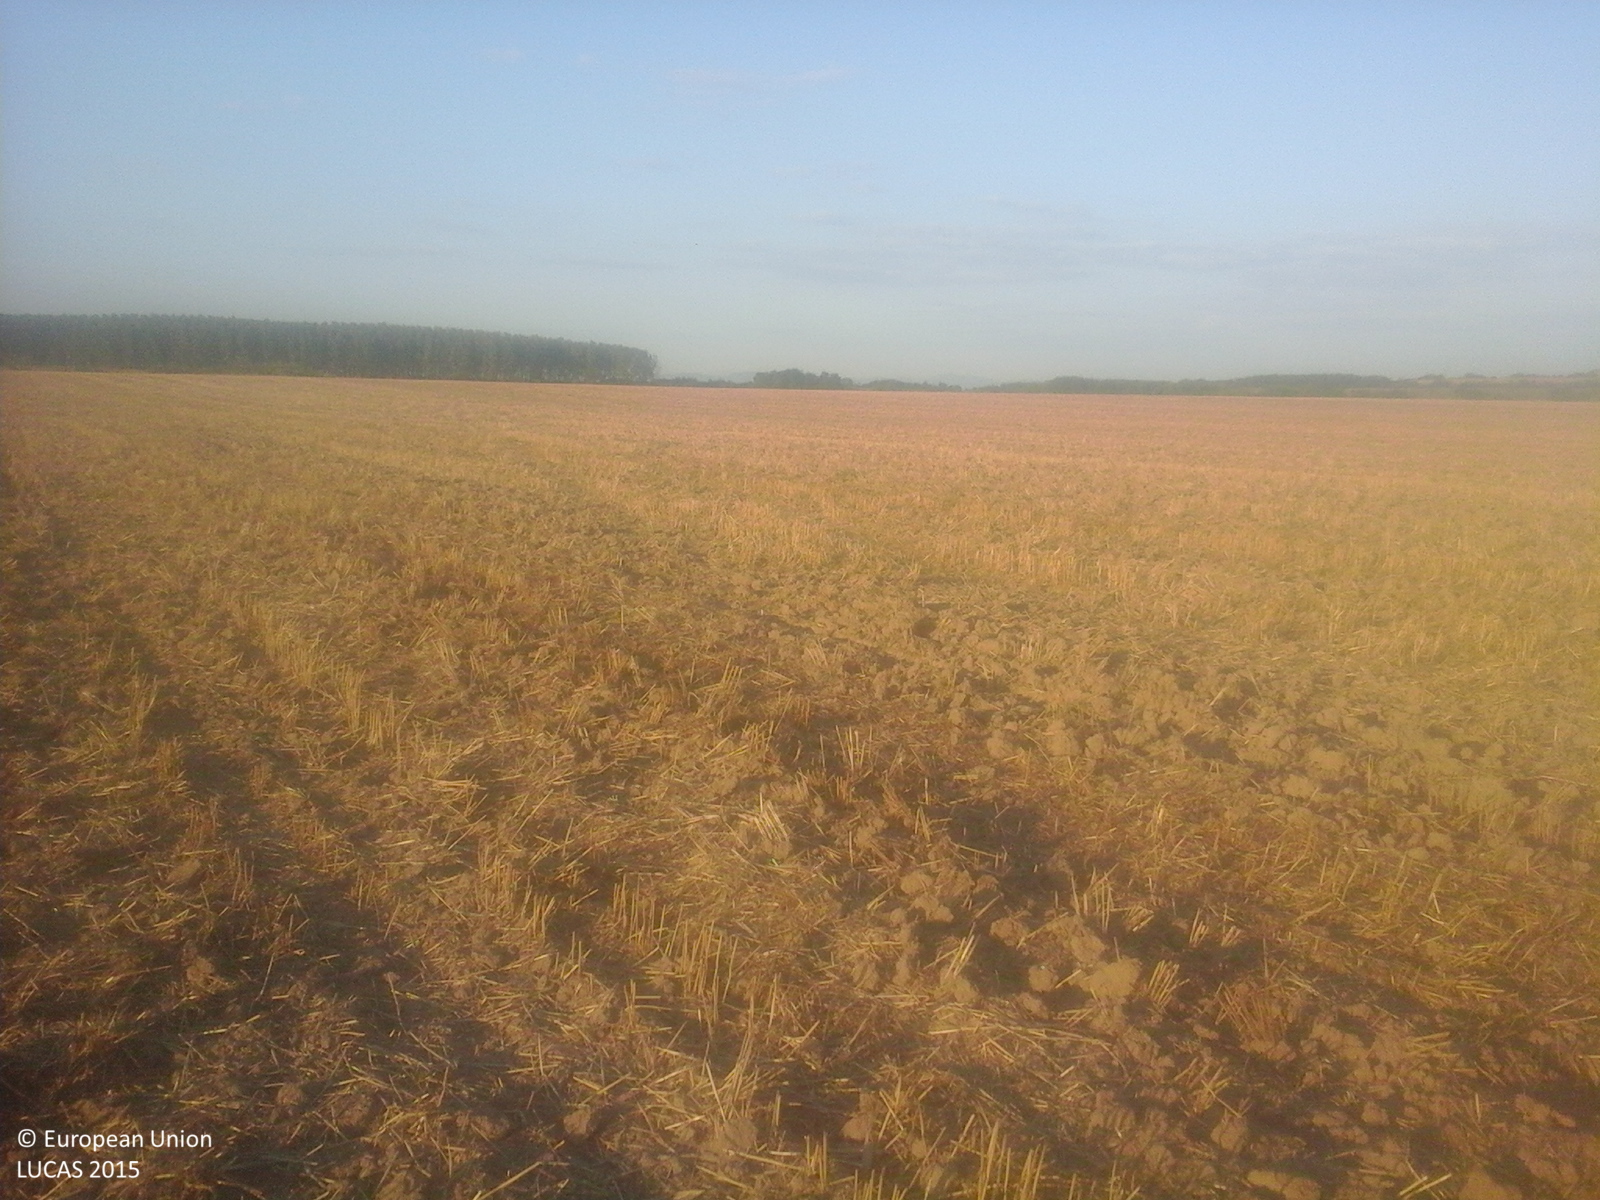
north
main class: Cropland
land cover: Common wheat
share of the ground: 10 - 25 %
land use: Agriculture (excluding fallow land and kitchen gardens)
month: September
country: RO
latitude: 47.6814
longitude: 22.8924
